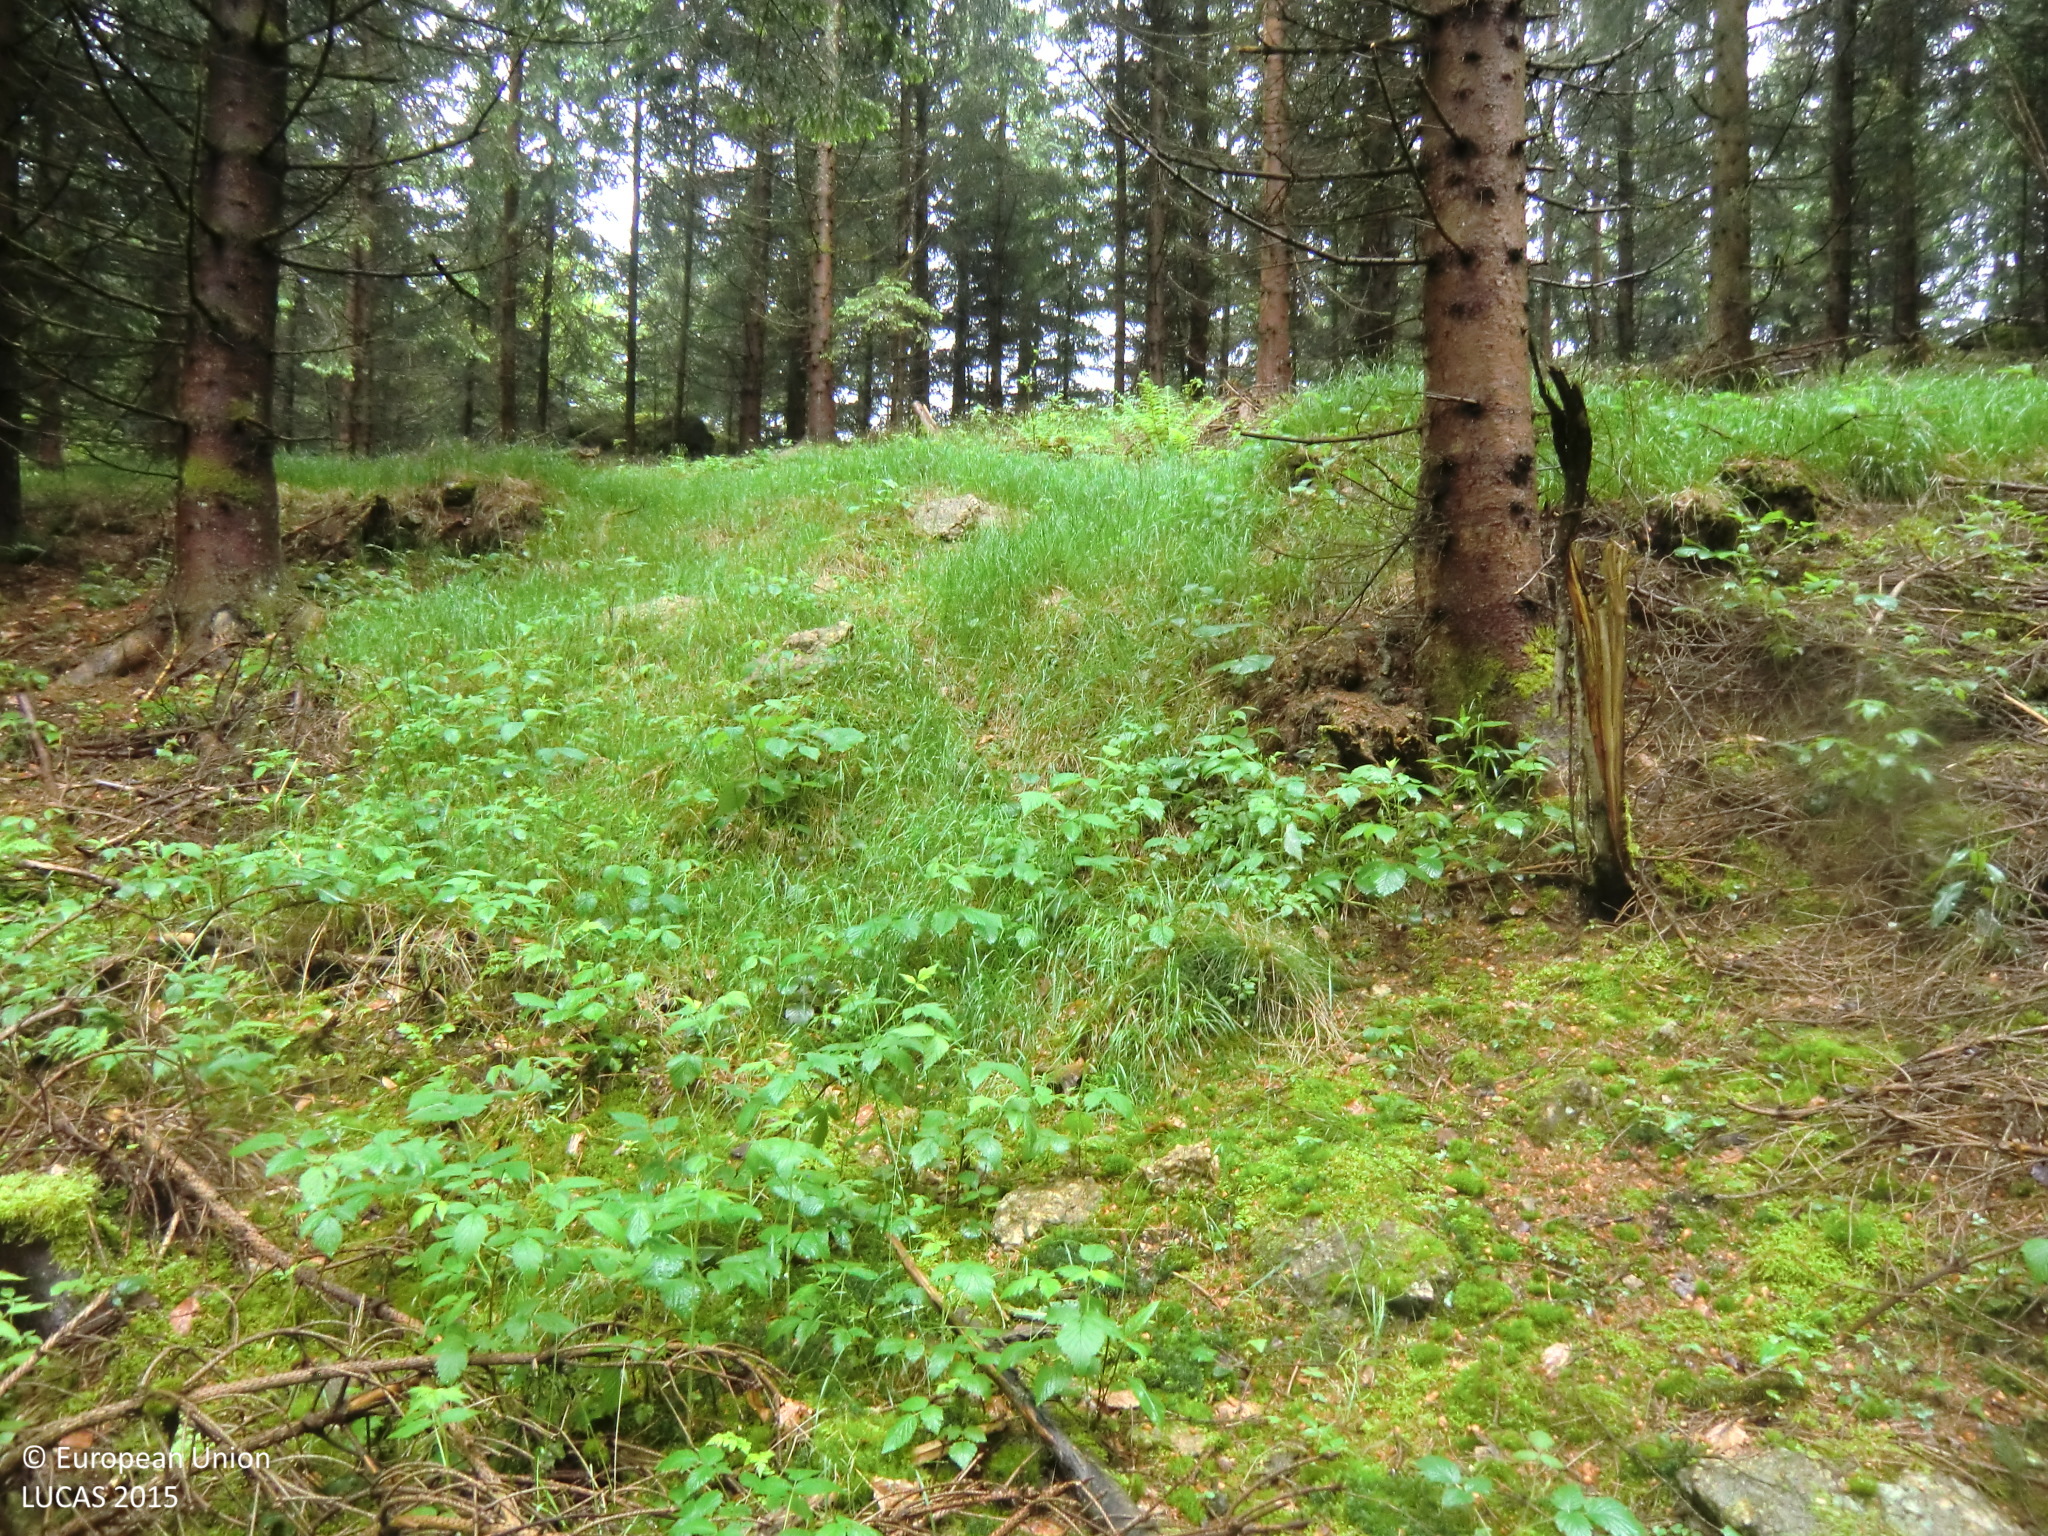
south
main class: Woodland
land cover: Spruce dominated coniferous woodland
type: hemiboreal forest and nemoral coniferous forest and mixed broadleaved-coniferous forest
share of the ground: > 75 %
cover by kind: coniferous forest trees 75 %, herbaceous plants 10 %, lichens and mosses 10 %, unconsolidated bare surface 5 %
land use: Forestry
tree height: > 5 m
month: May
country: AT
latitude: 48.3728
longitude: 14.7665
